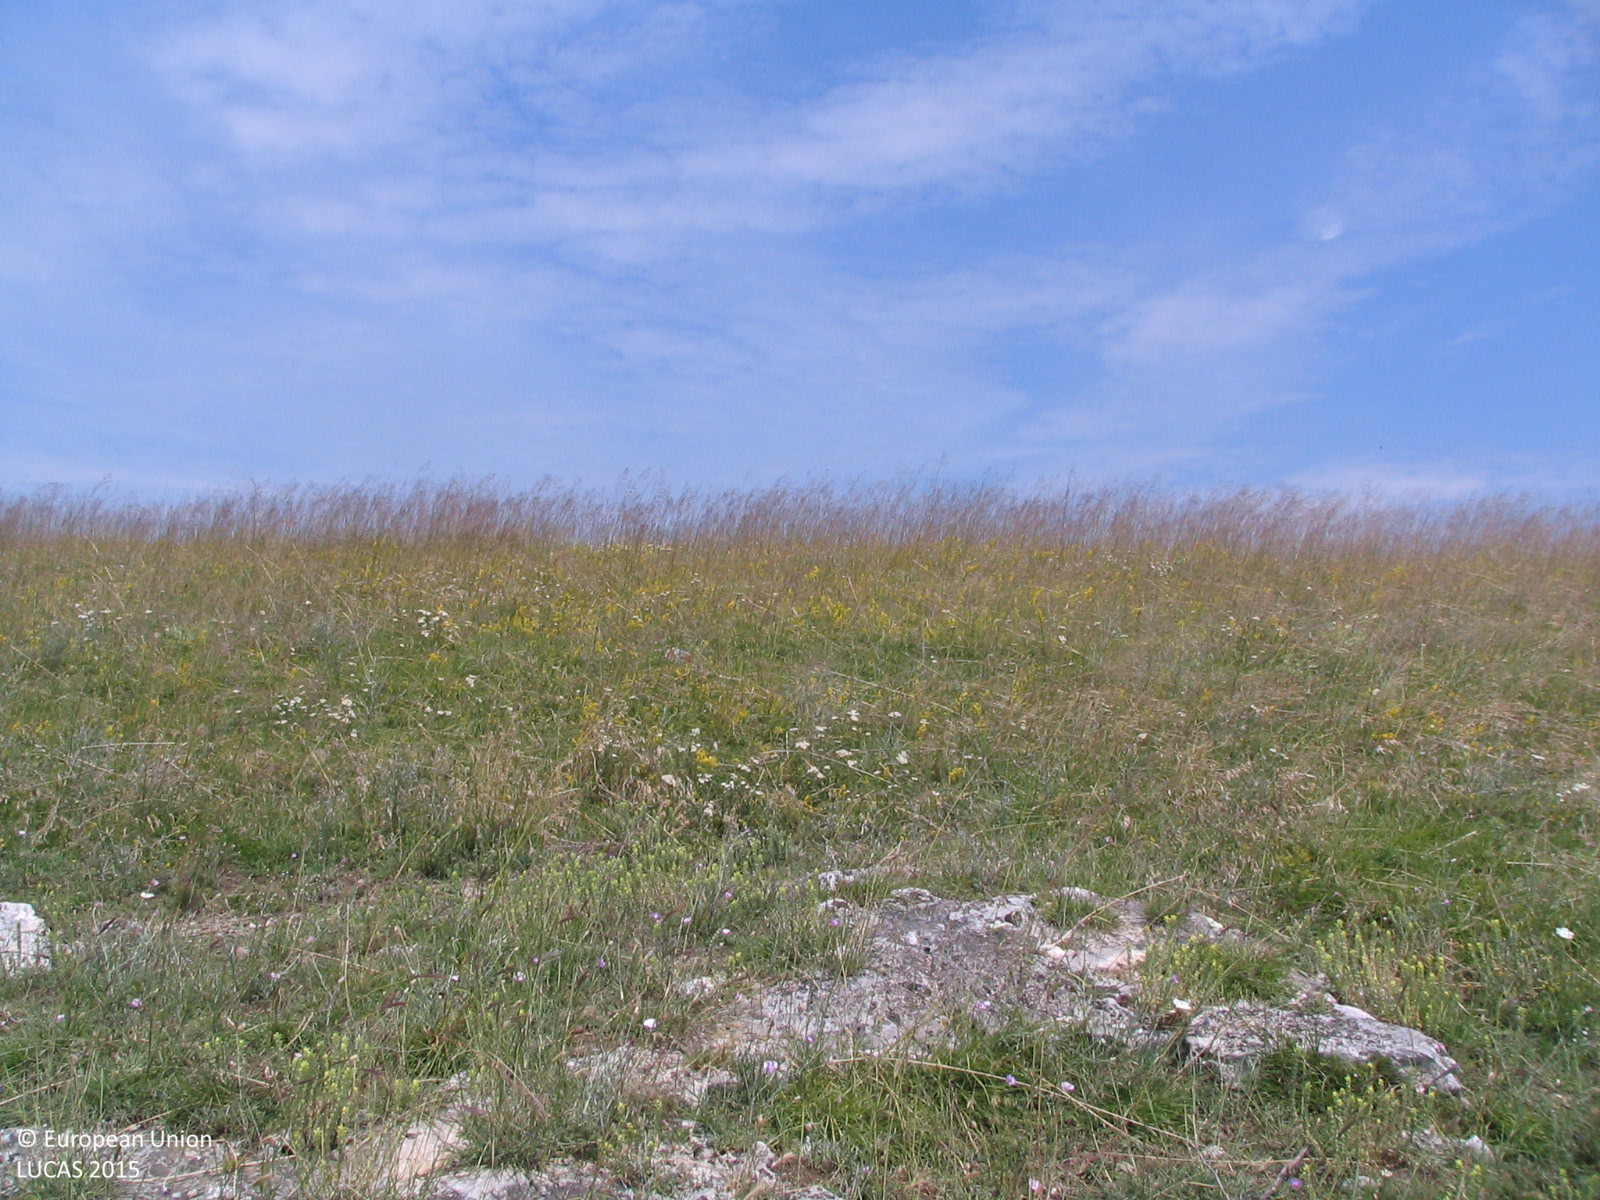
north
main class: Grassland
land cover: Grassland with sparse tree/shrub cover
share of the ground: > 75 %
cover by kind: herbaceous plants 85 %, shrubs 10 %, broadleaved forest trees 5 %
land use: Agriculture (excluding fallow land and kitchen gardens)
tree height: < 5 m
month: June
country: BG
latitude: 43.2811
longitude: 24.0379
